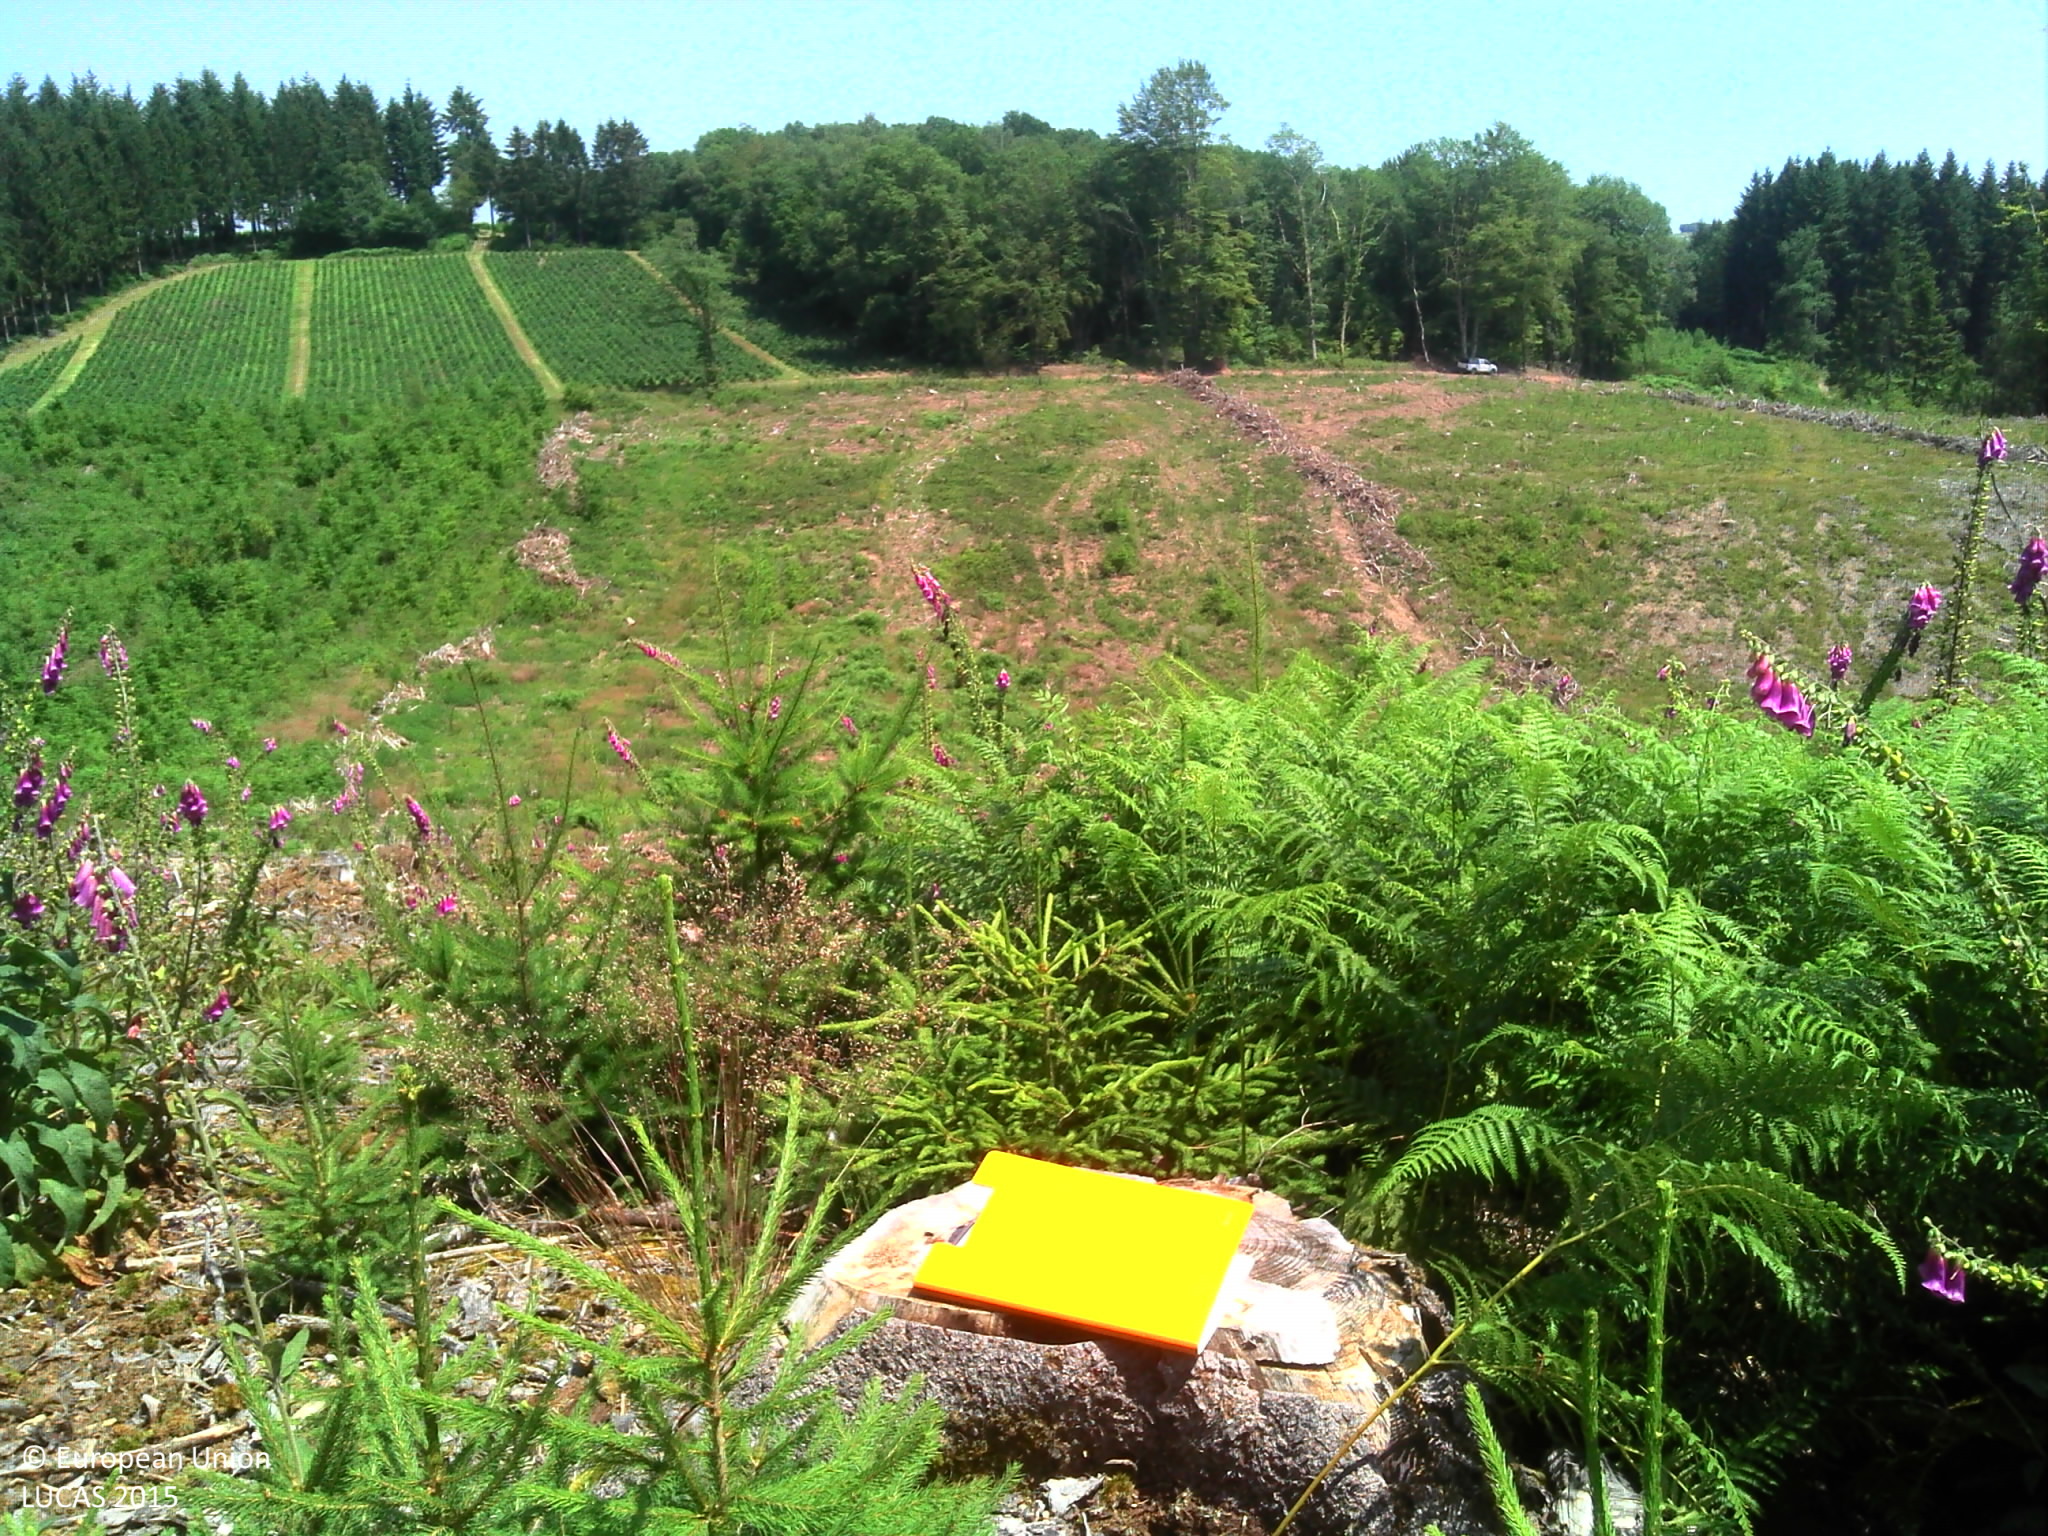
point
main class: Woodland
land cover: Spruce dominated coniferous woodland
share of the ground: > 75 %
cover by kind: coniferous forest trees 100 %
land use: Forestry
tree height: < 5 m
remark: Clear cut
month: July
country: FR
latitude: 47.1397
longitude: 3.9993
